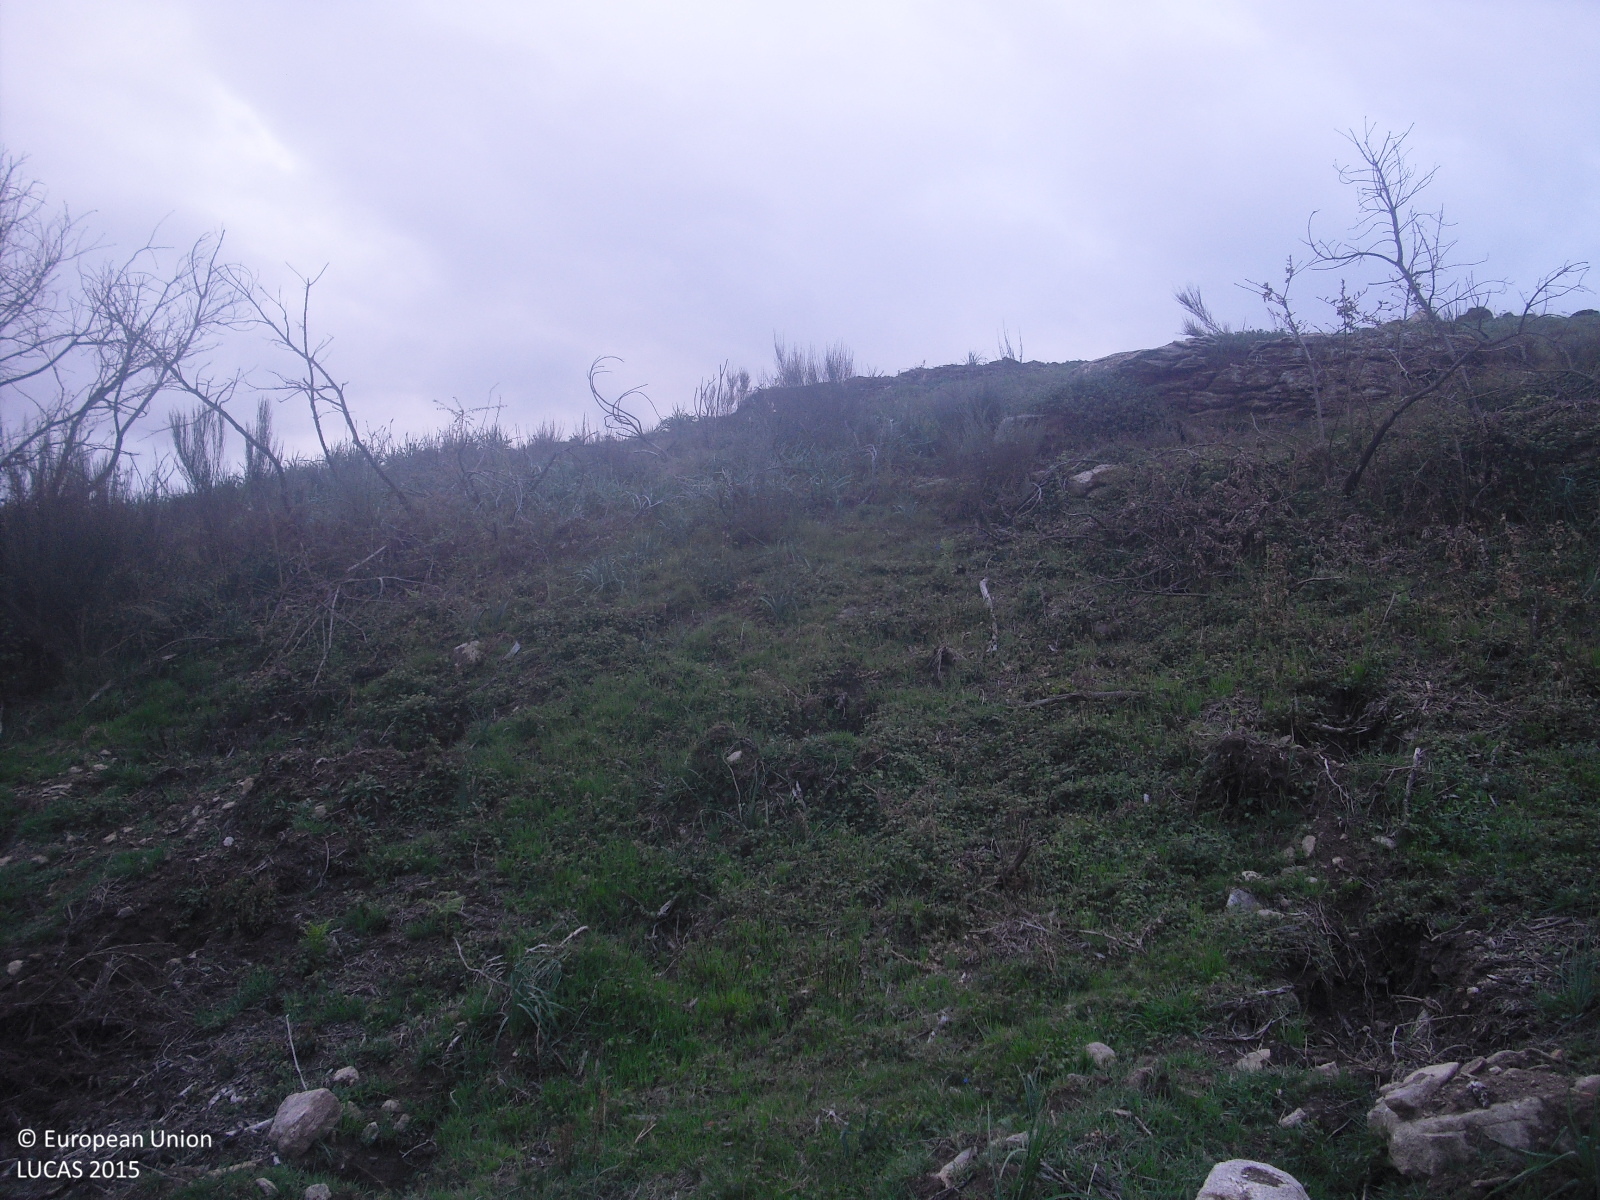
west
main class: Grassland
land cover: Grassland with sparse tree/shrub cover
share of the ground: 50 - 75 %
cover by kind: herbaceous plants 85 %, shrubs 10 %, coniferous forest trees 5 %
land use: Forestry
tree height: < 5 m
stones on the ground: < 10 %
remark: Burnt area
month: April
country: ES
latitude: 42.0418
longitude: -7.8928
